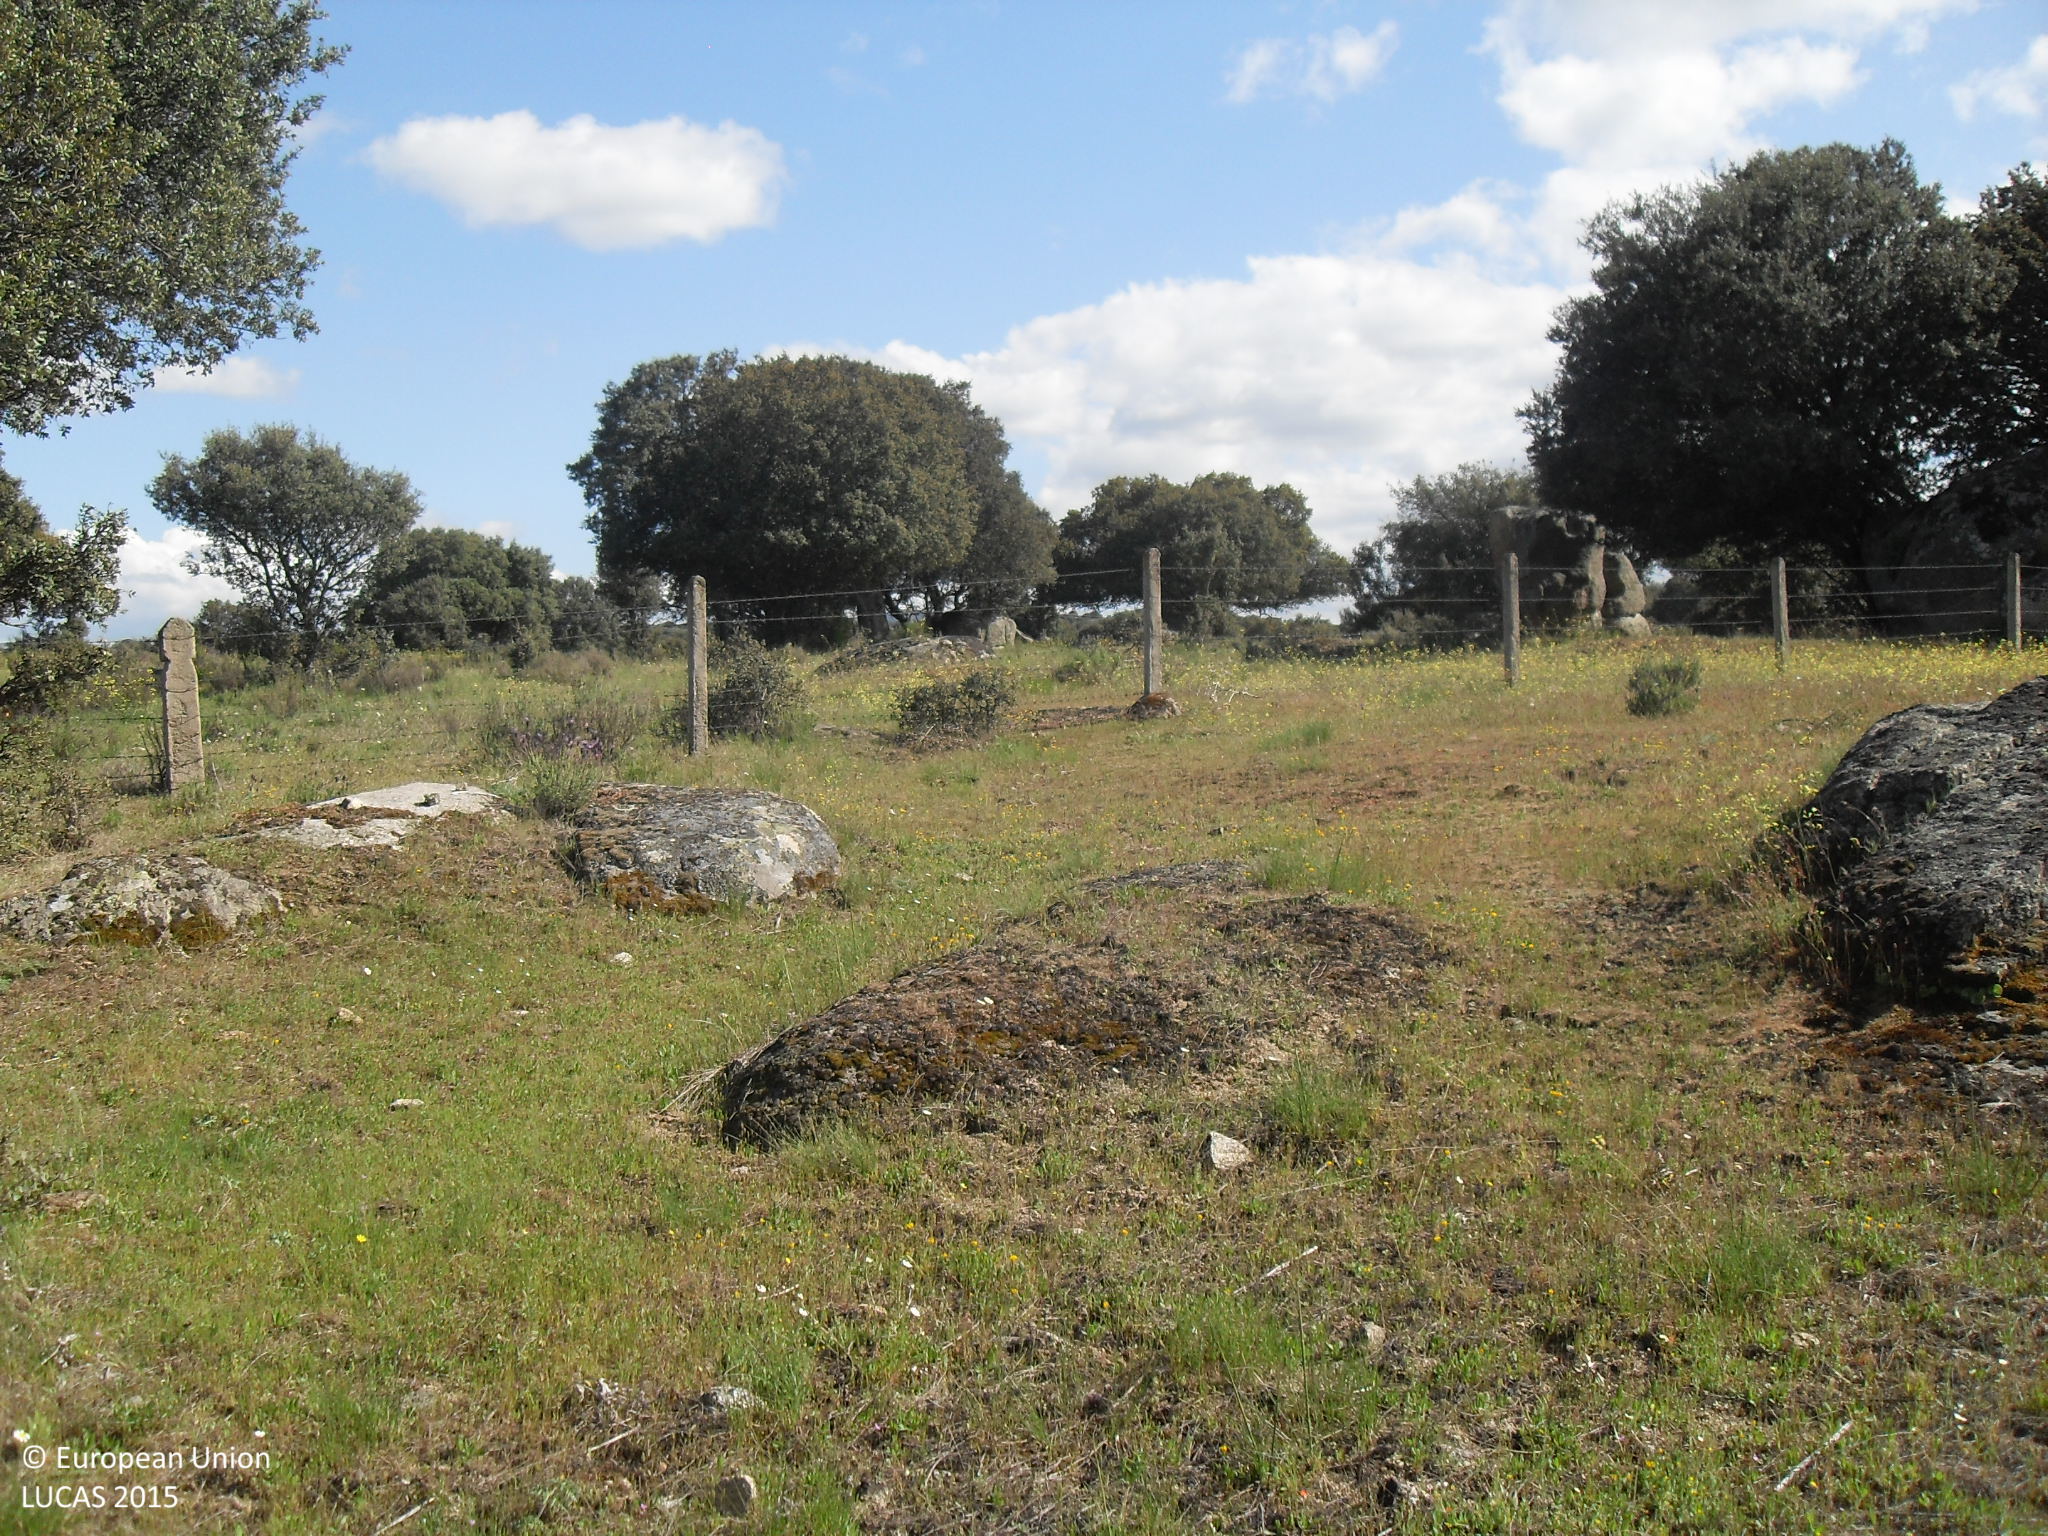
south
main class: Woodland
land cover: Broadleaved woodland
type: broadleaved evergreen forest
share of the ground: 10 - 25 %
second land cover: Grassland without tree/shrub cover
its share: > 75 %
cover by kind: herbaceous plants 85 %, broadleaved forest trees 15 %
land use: Forestry
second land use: Agriculture (excluding fallow land and kitchen gardens)
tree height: < 5 m
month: May
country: ES
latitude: 40.6808
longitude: -5.2693
